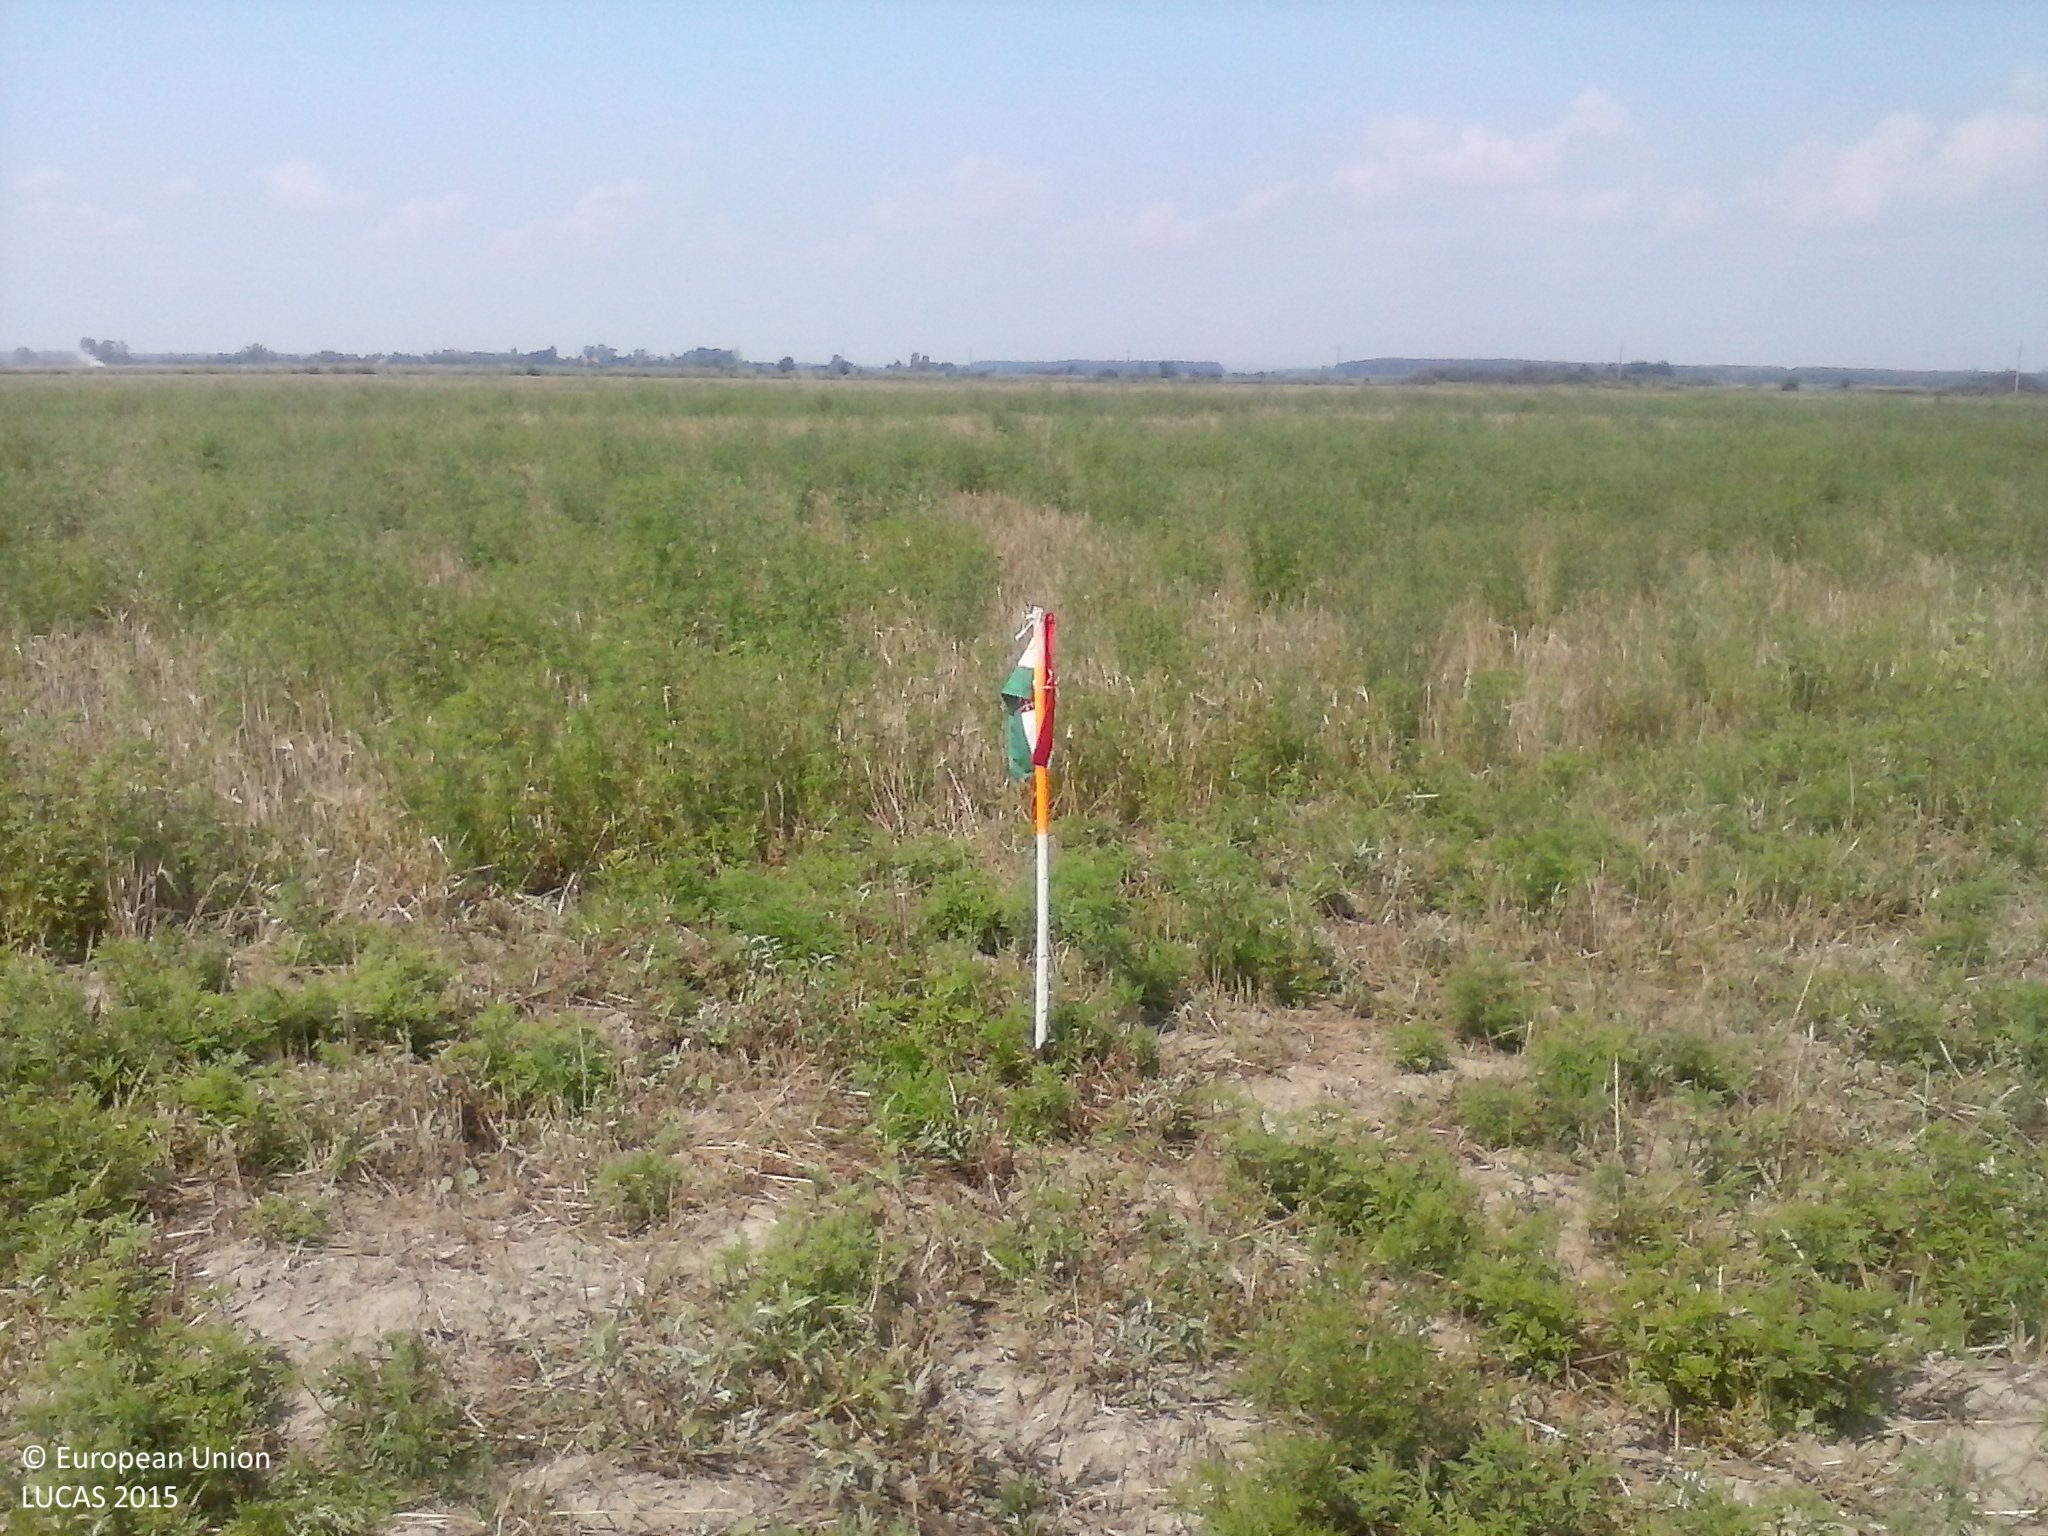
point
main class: Cropland
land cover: Triticale
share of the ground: 25 - 50 %
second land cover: Spontaneously vegetated surfaces
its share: 50 - 75 %
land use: Agriculture (excluding fallow land and kitchen gardens)
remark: Harvested field
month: August
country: HU
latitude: 45.9351
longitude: 17.8592
